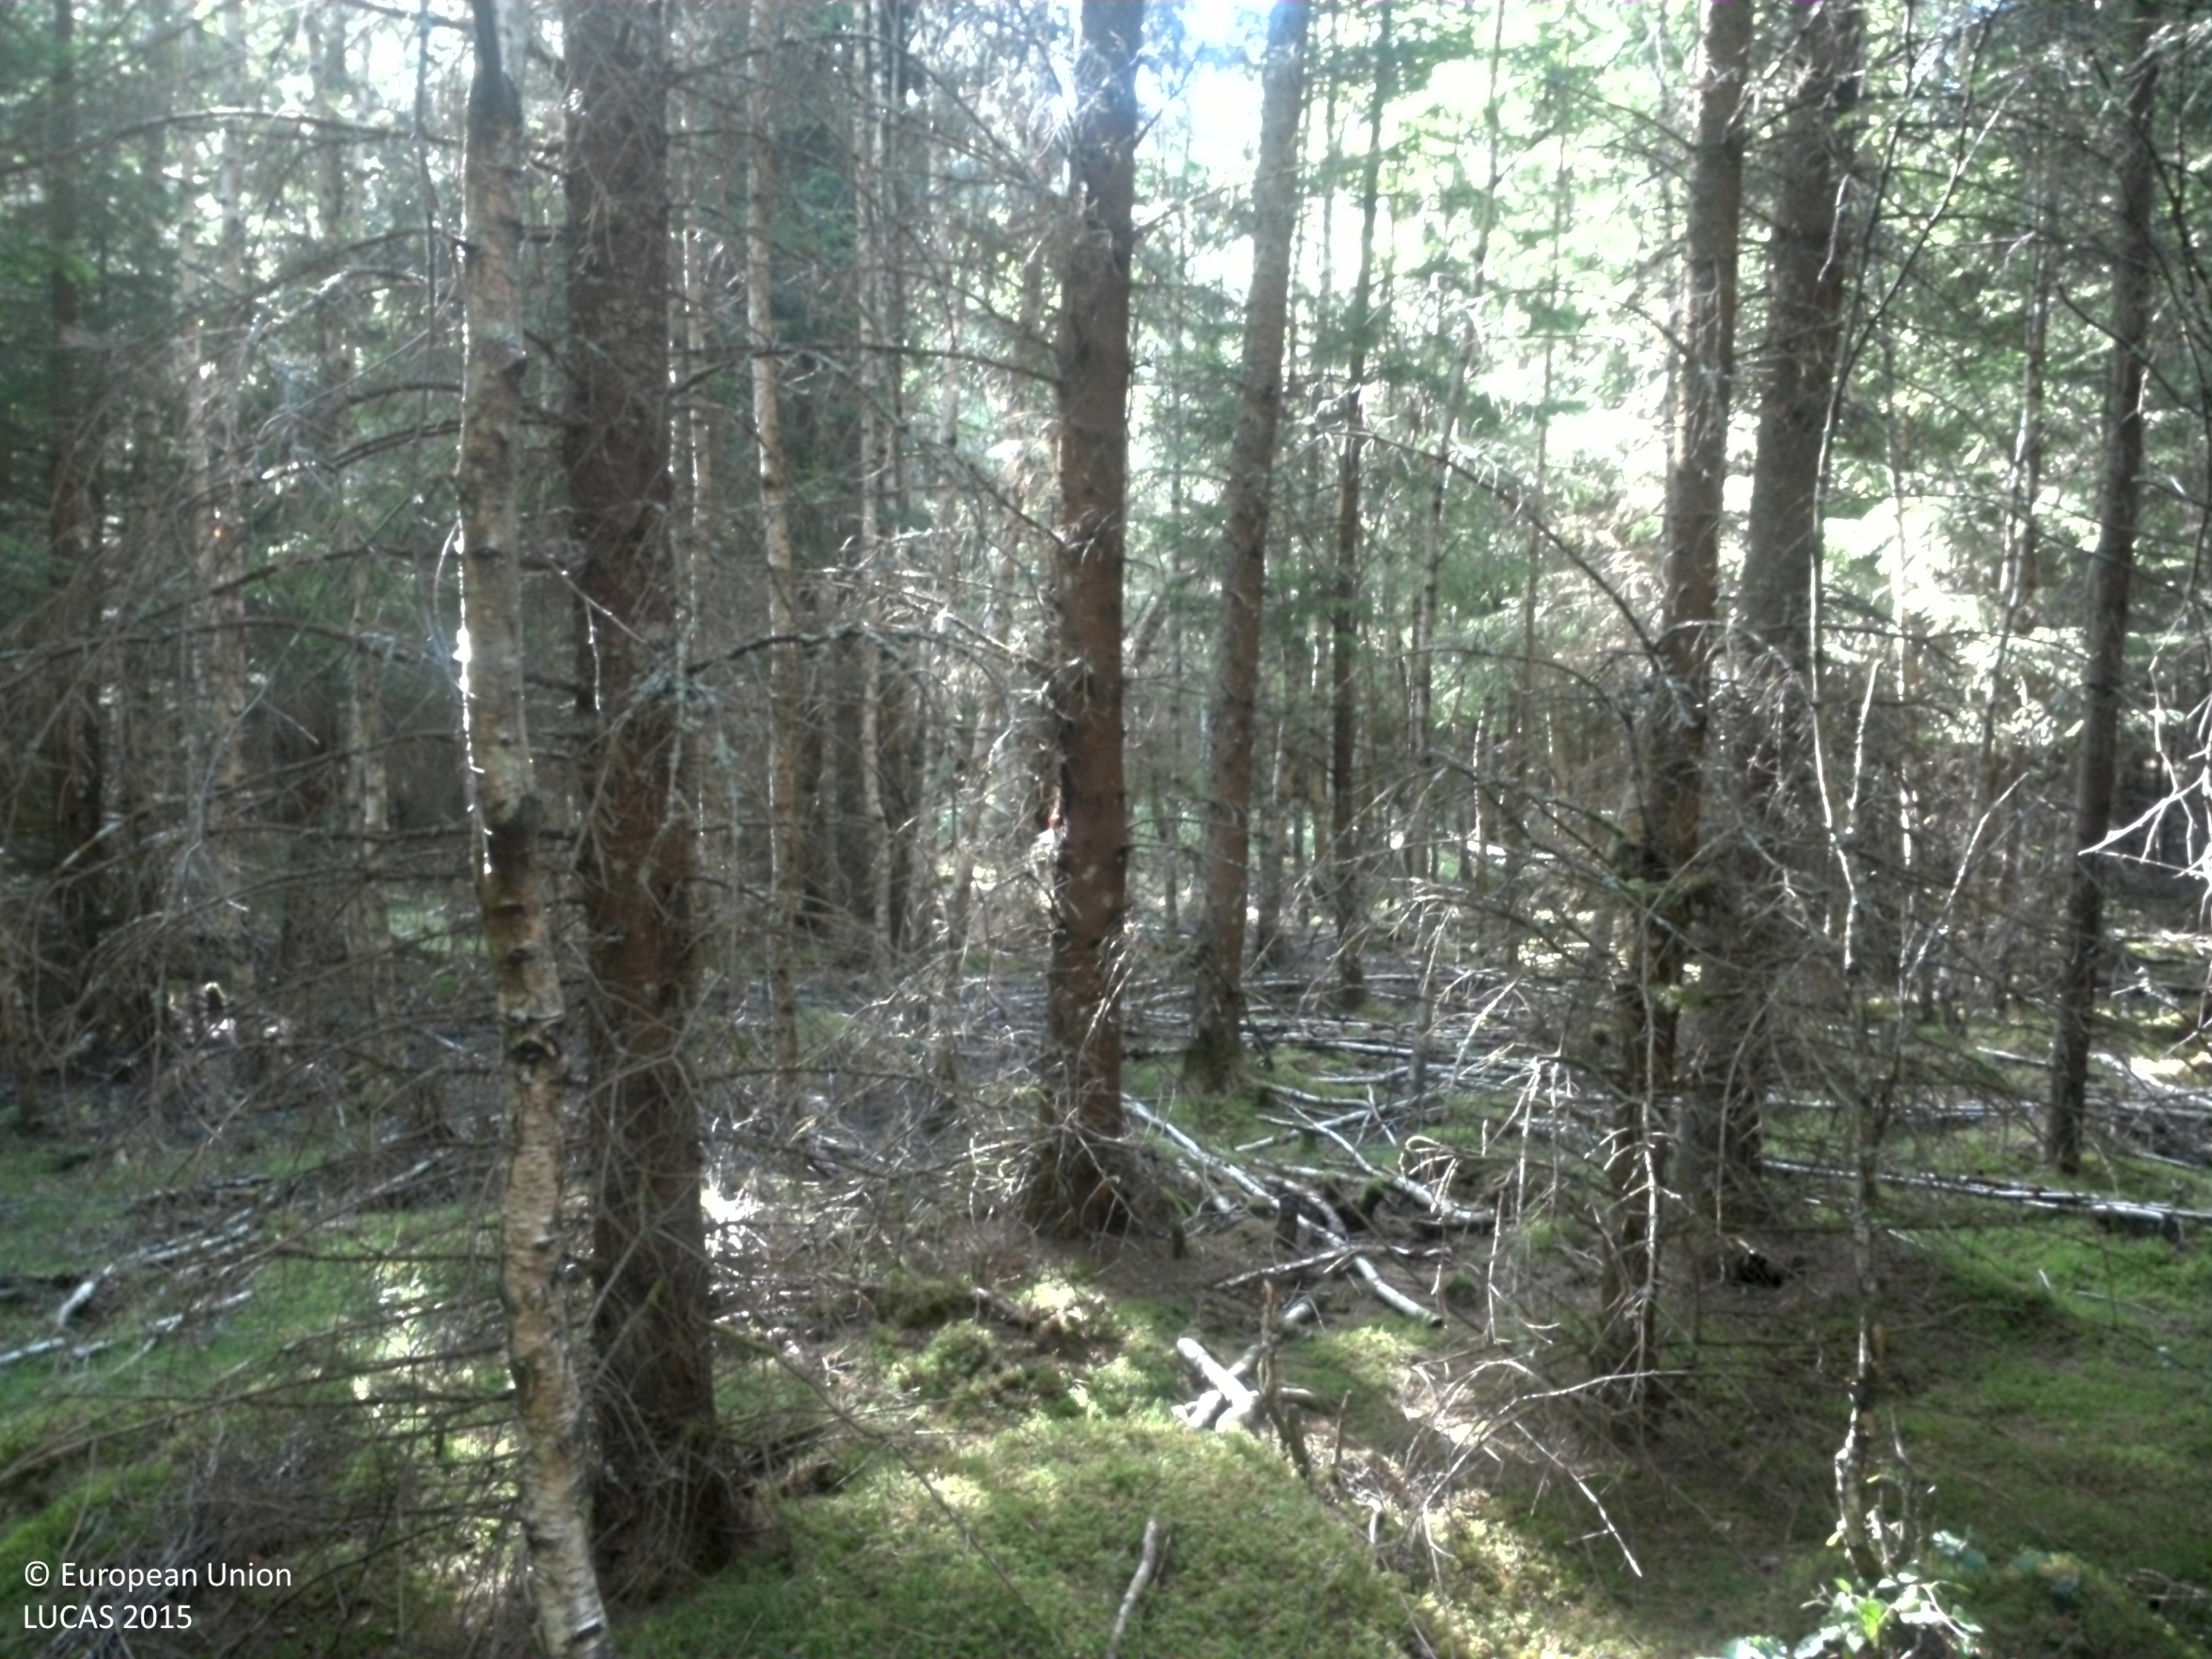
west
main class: Woodland
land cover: Spruce dominated coniferous woodland
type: boreal forest
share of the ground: 50 - 75 %
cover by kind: coniferous forest trees 70 %, lichens and mosses 25 %, herbaceous plants 5 %
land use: Forestry
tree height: > 5 m
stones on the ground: < 10 %
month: August
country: SE
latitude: 58.1608
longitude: 13.3087
